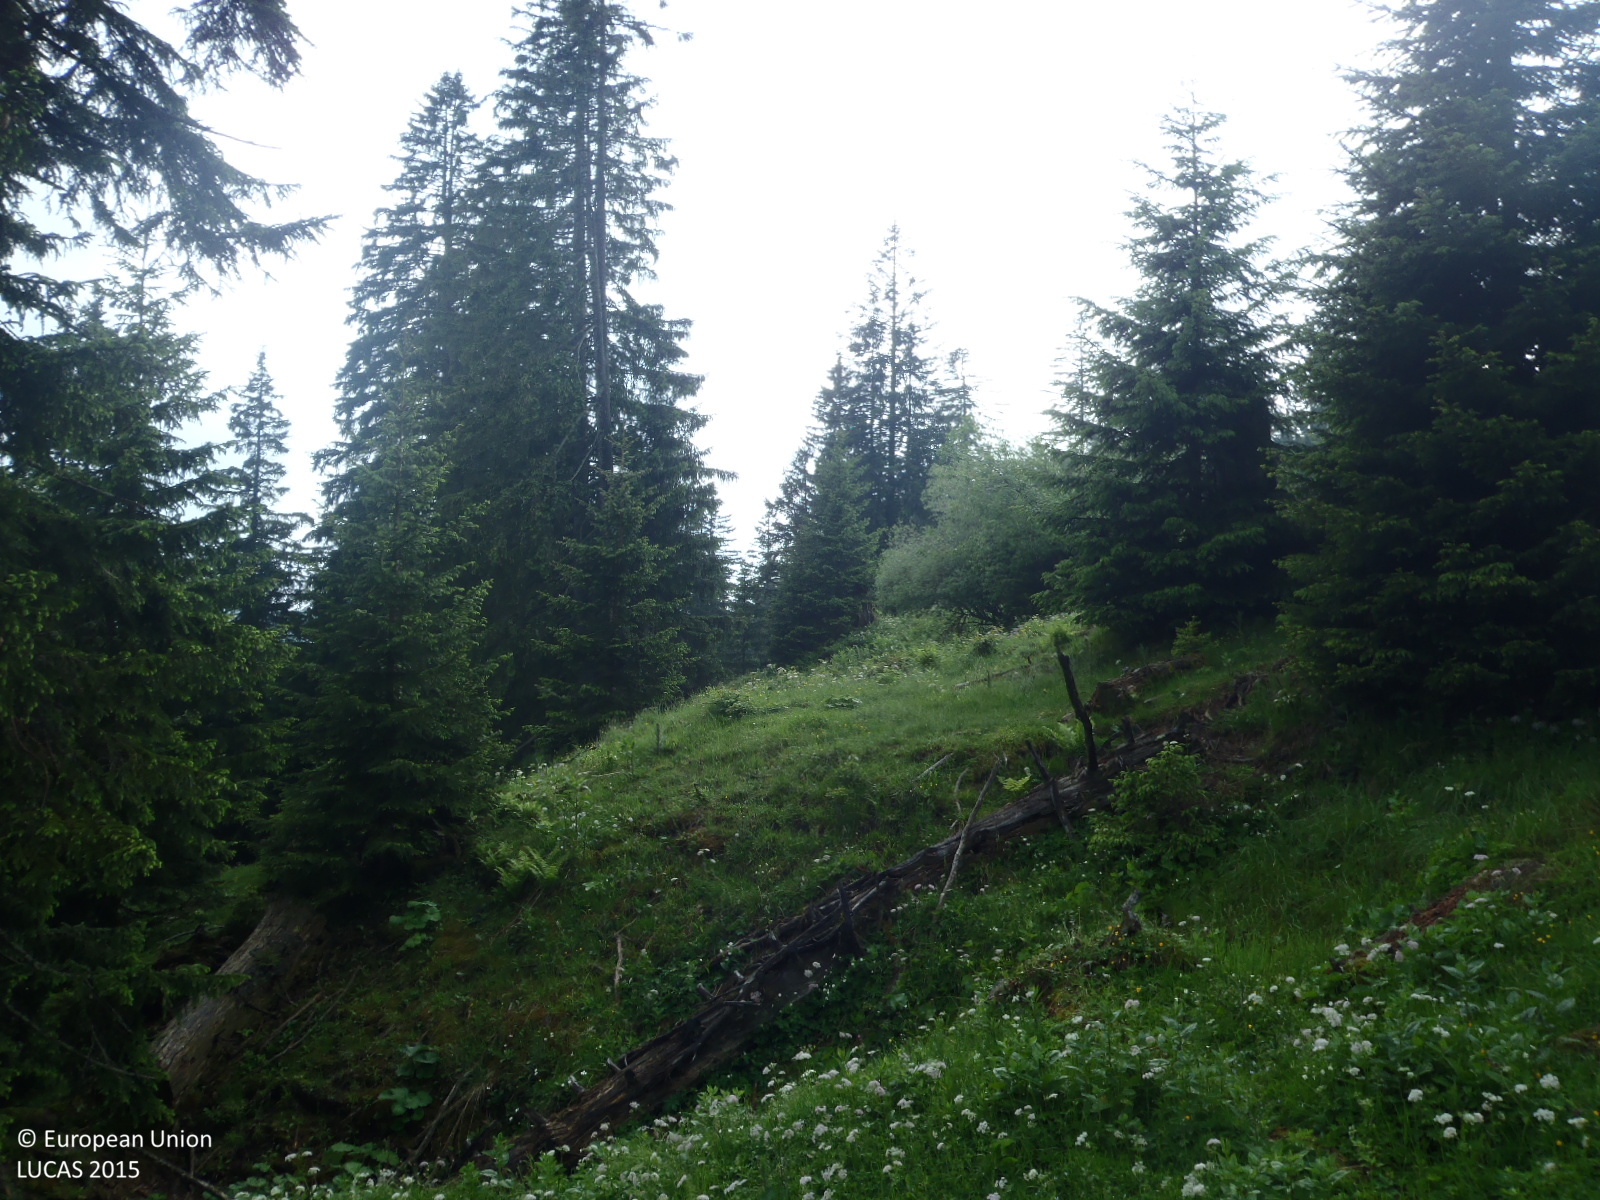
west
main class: Woodland
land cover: Spruce dominated coniferous woodland
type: alpine coniferous forest
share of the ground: 10 - 25 %
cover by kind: herbaceous plants 80 %, coniferous forest trees 20 %
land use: Agriculture (excluding fallow land and kitchen gardens)
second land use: Forestry
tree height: > 5 m
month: June
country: AT
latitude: 47.5205
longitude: 10.4909
